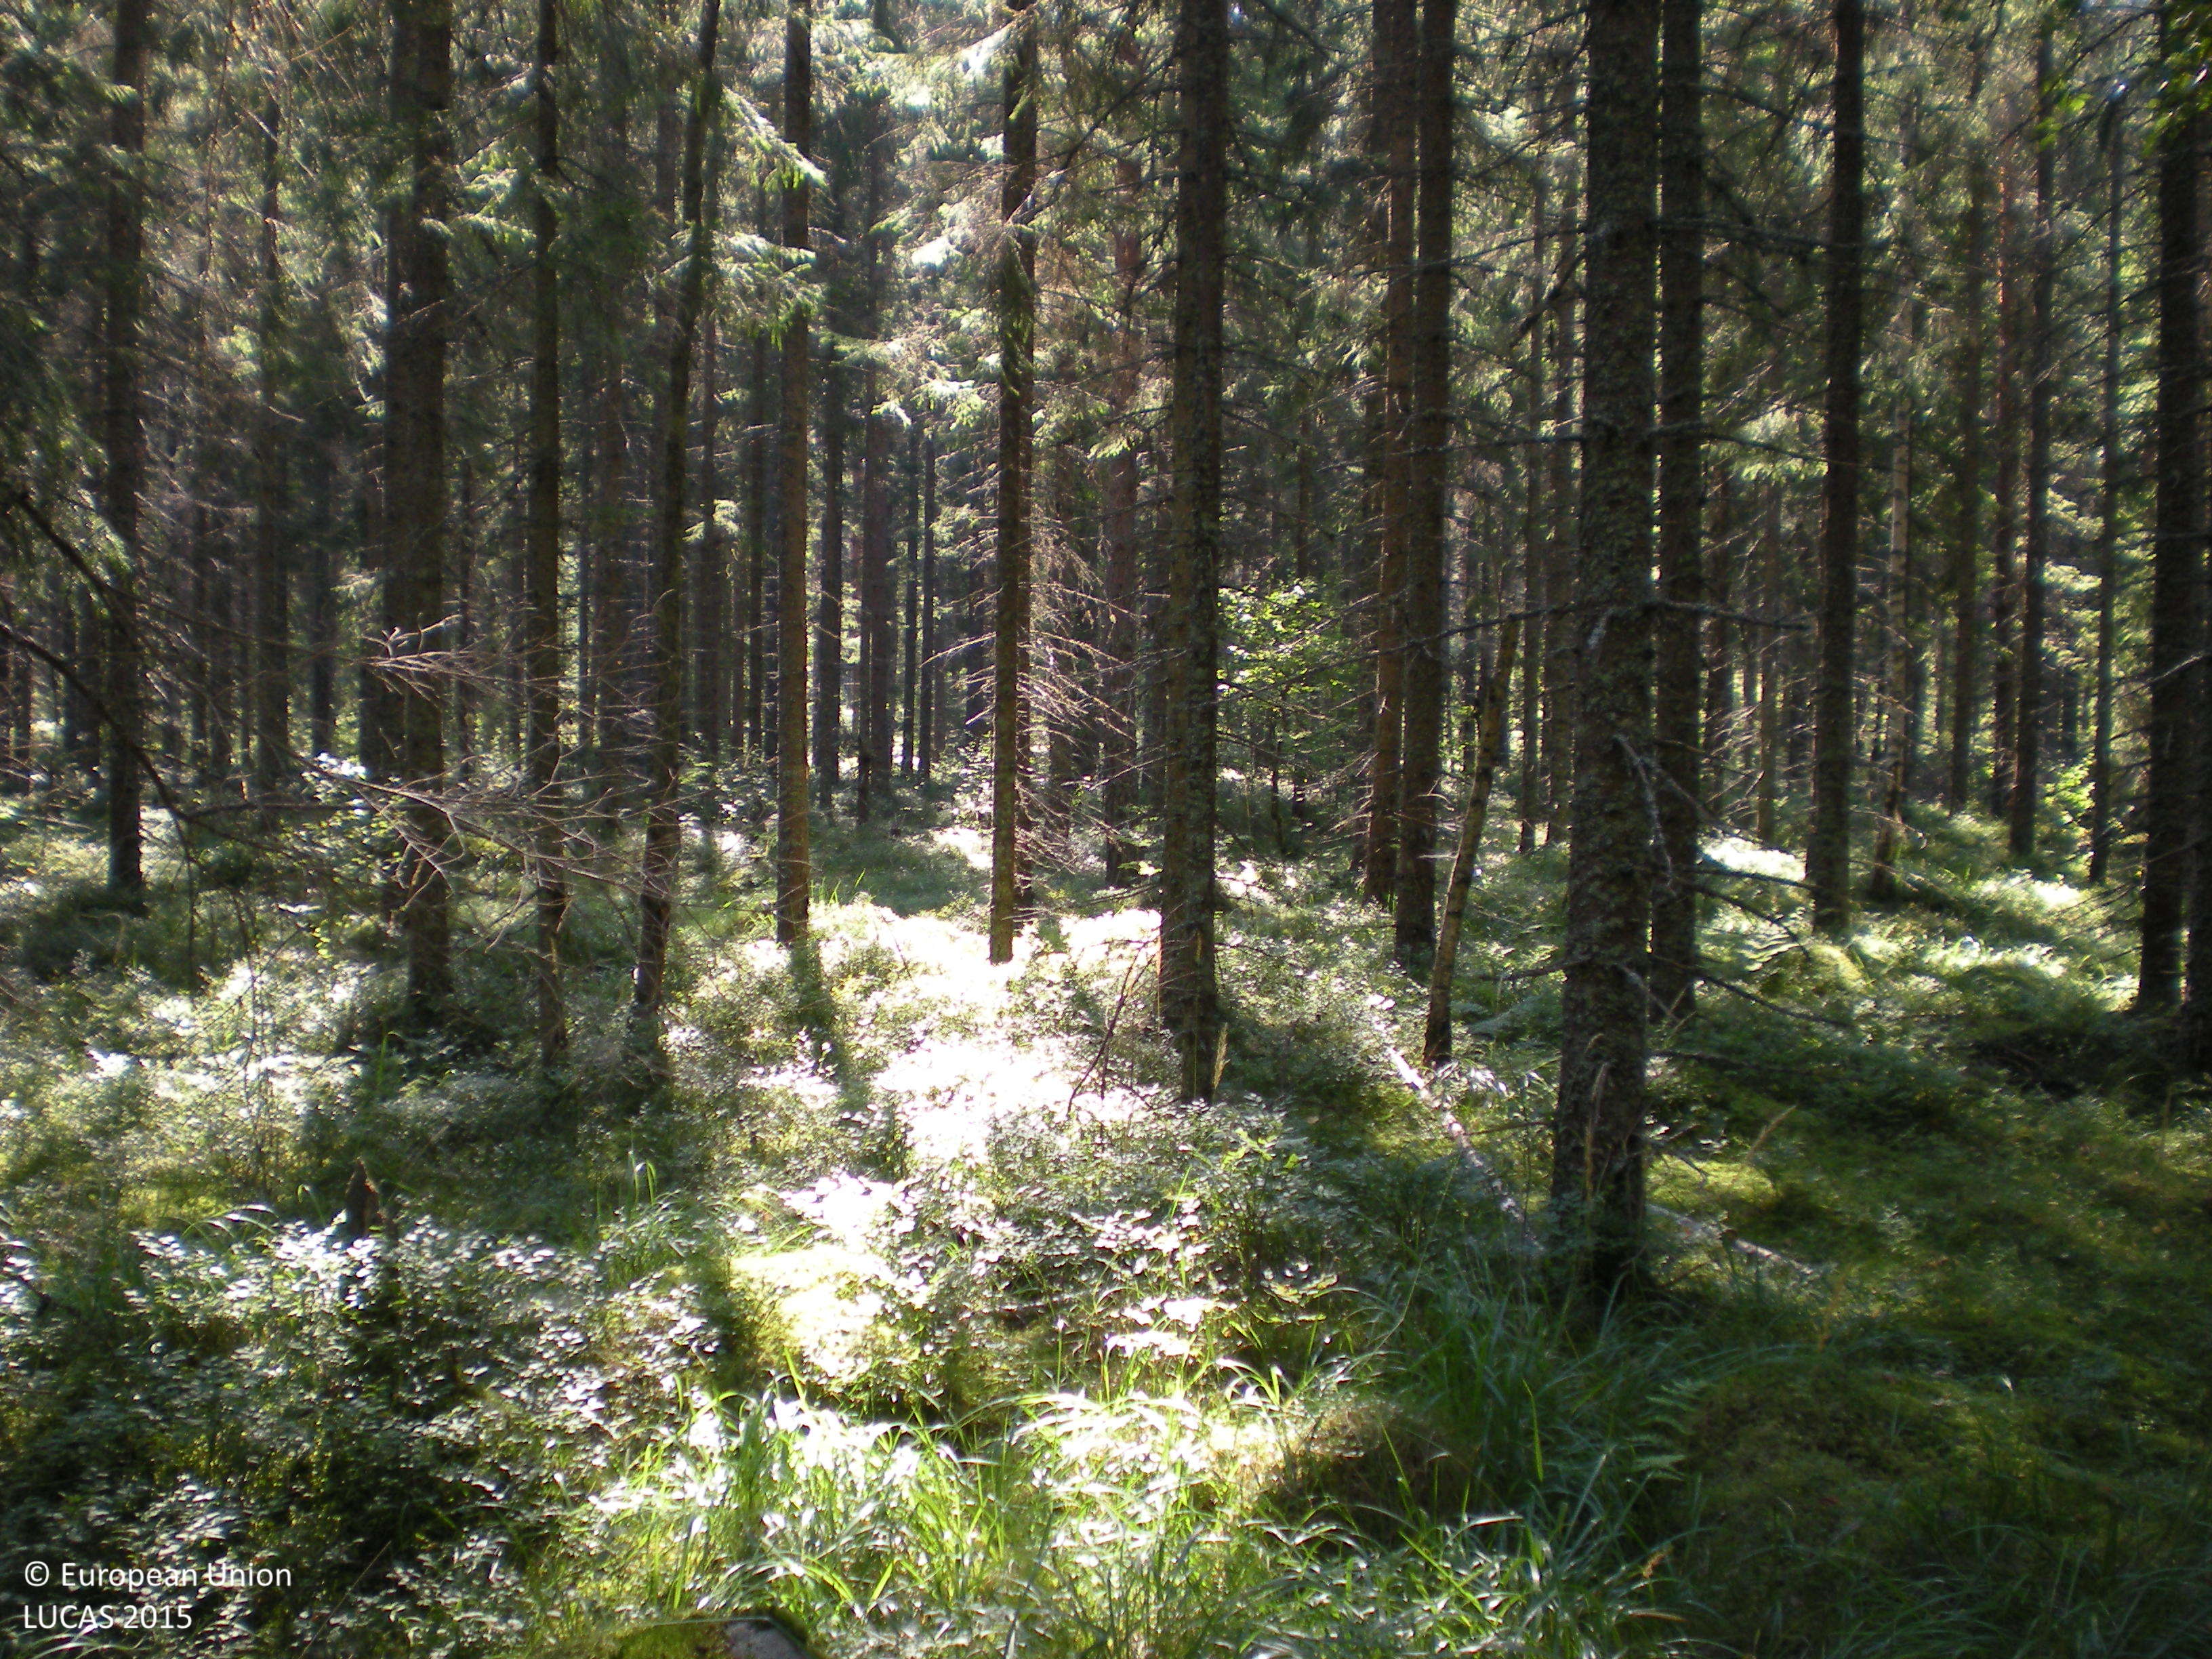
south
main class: Woodland
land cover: Spruce dominated coniferous woodland
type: boreal forest
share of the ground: 50 - 75 %
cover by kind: coniferous forest trees 70 %, shrubs 20 %, herbaceous plants 5 %, lichens and mosses 5 %
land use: Forestry
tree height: > 5 m
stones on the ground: 10 - 25 %
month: August
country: SE
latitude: 60.4486
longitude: 17.2064
